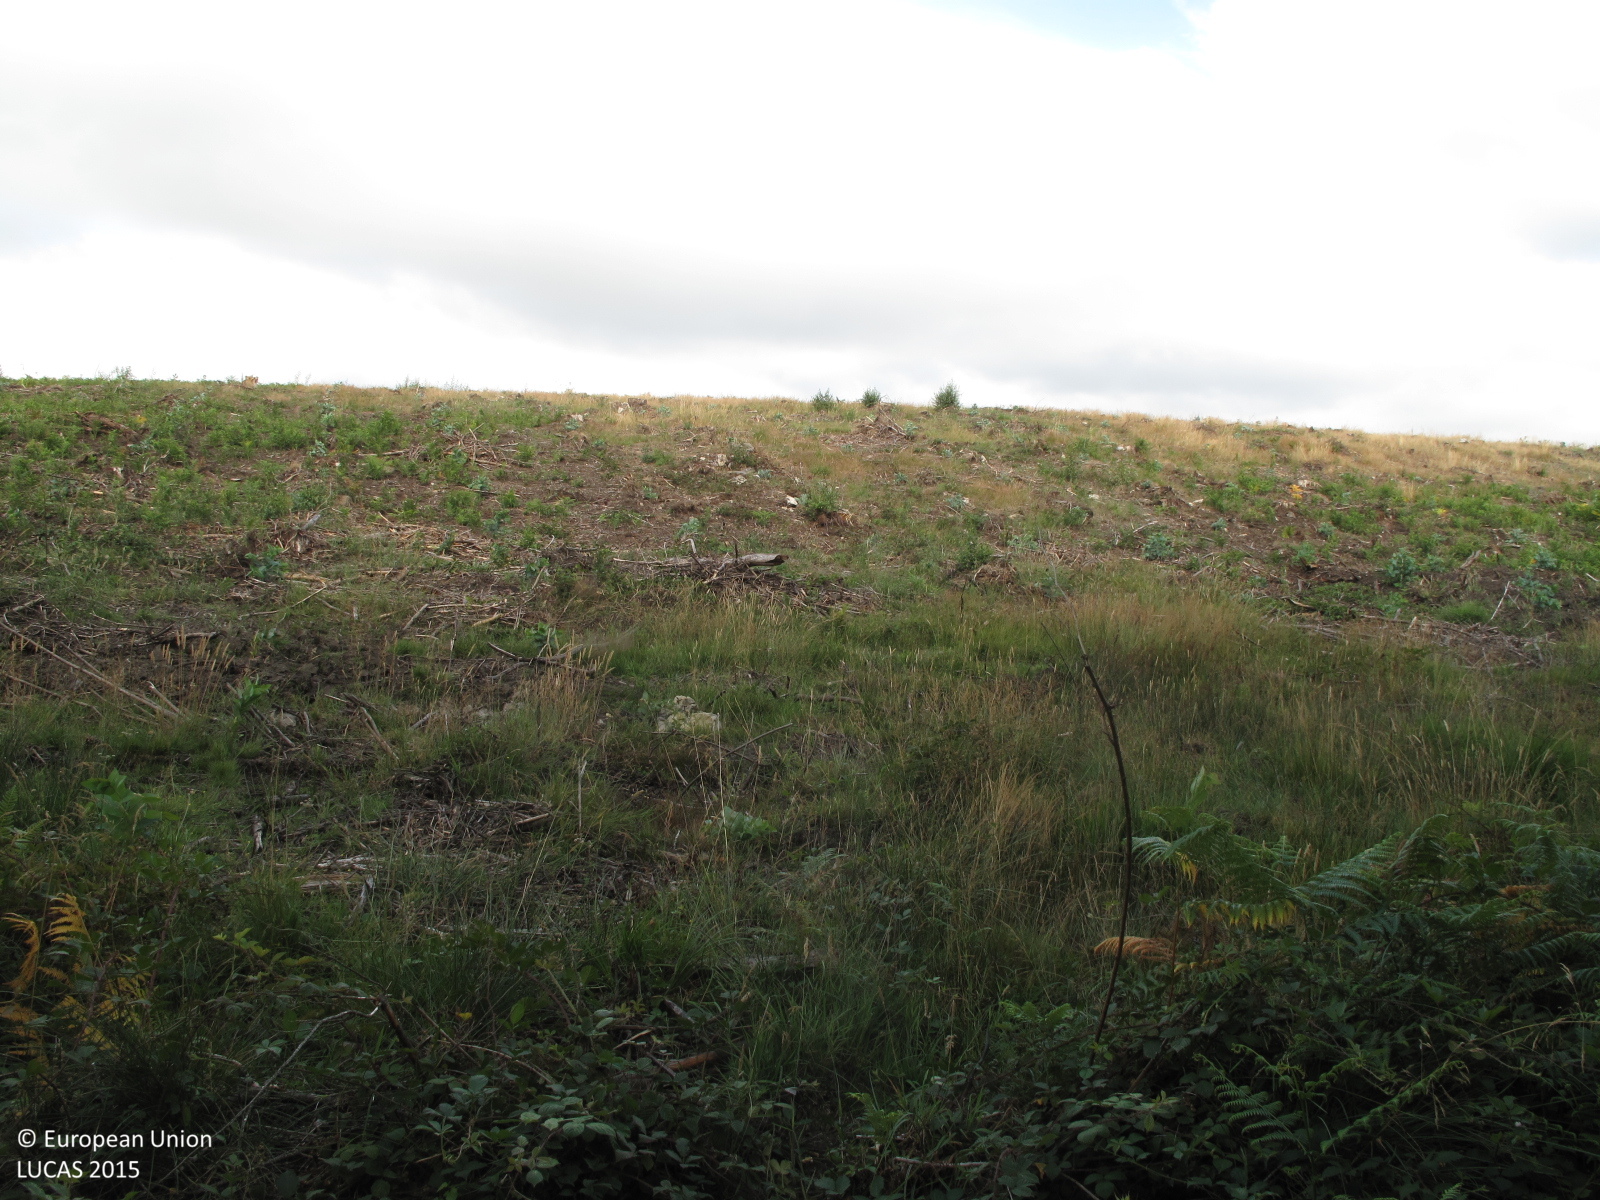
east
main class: Woodland
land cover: Broadleaved woodland
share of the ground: > 75 %
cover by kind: broadleaved forest trees 90 %, shrubs 10 %
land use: Semi-natural and natural areas not in use
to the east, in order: Broadleaved woodland; Shrubland without tree cover; Grassland with sparse tree/shrub cover
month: July
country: ES
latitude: 43.1159
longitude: -7.9722
